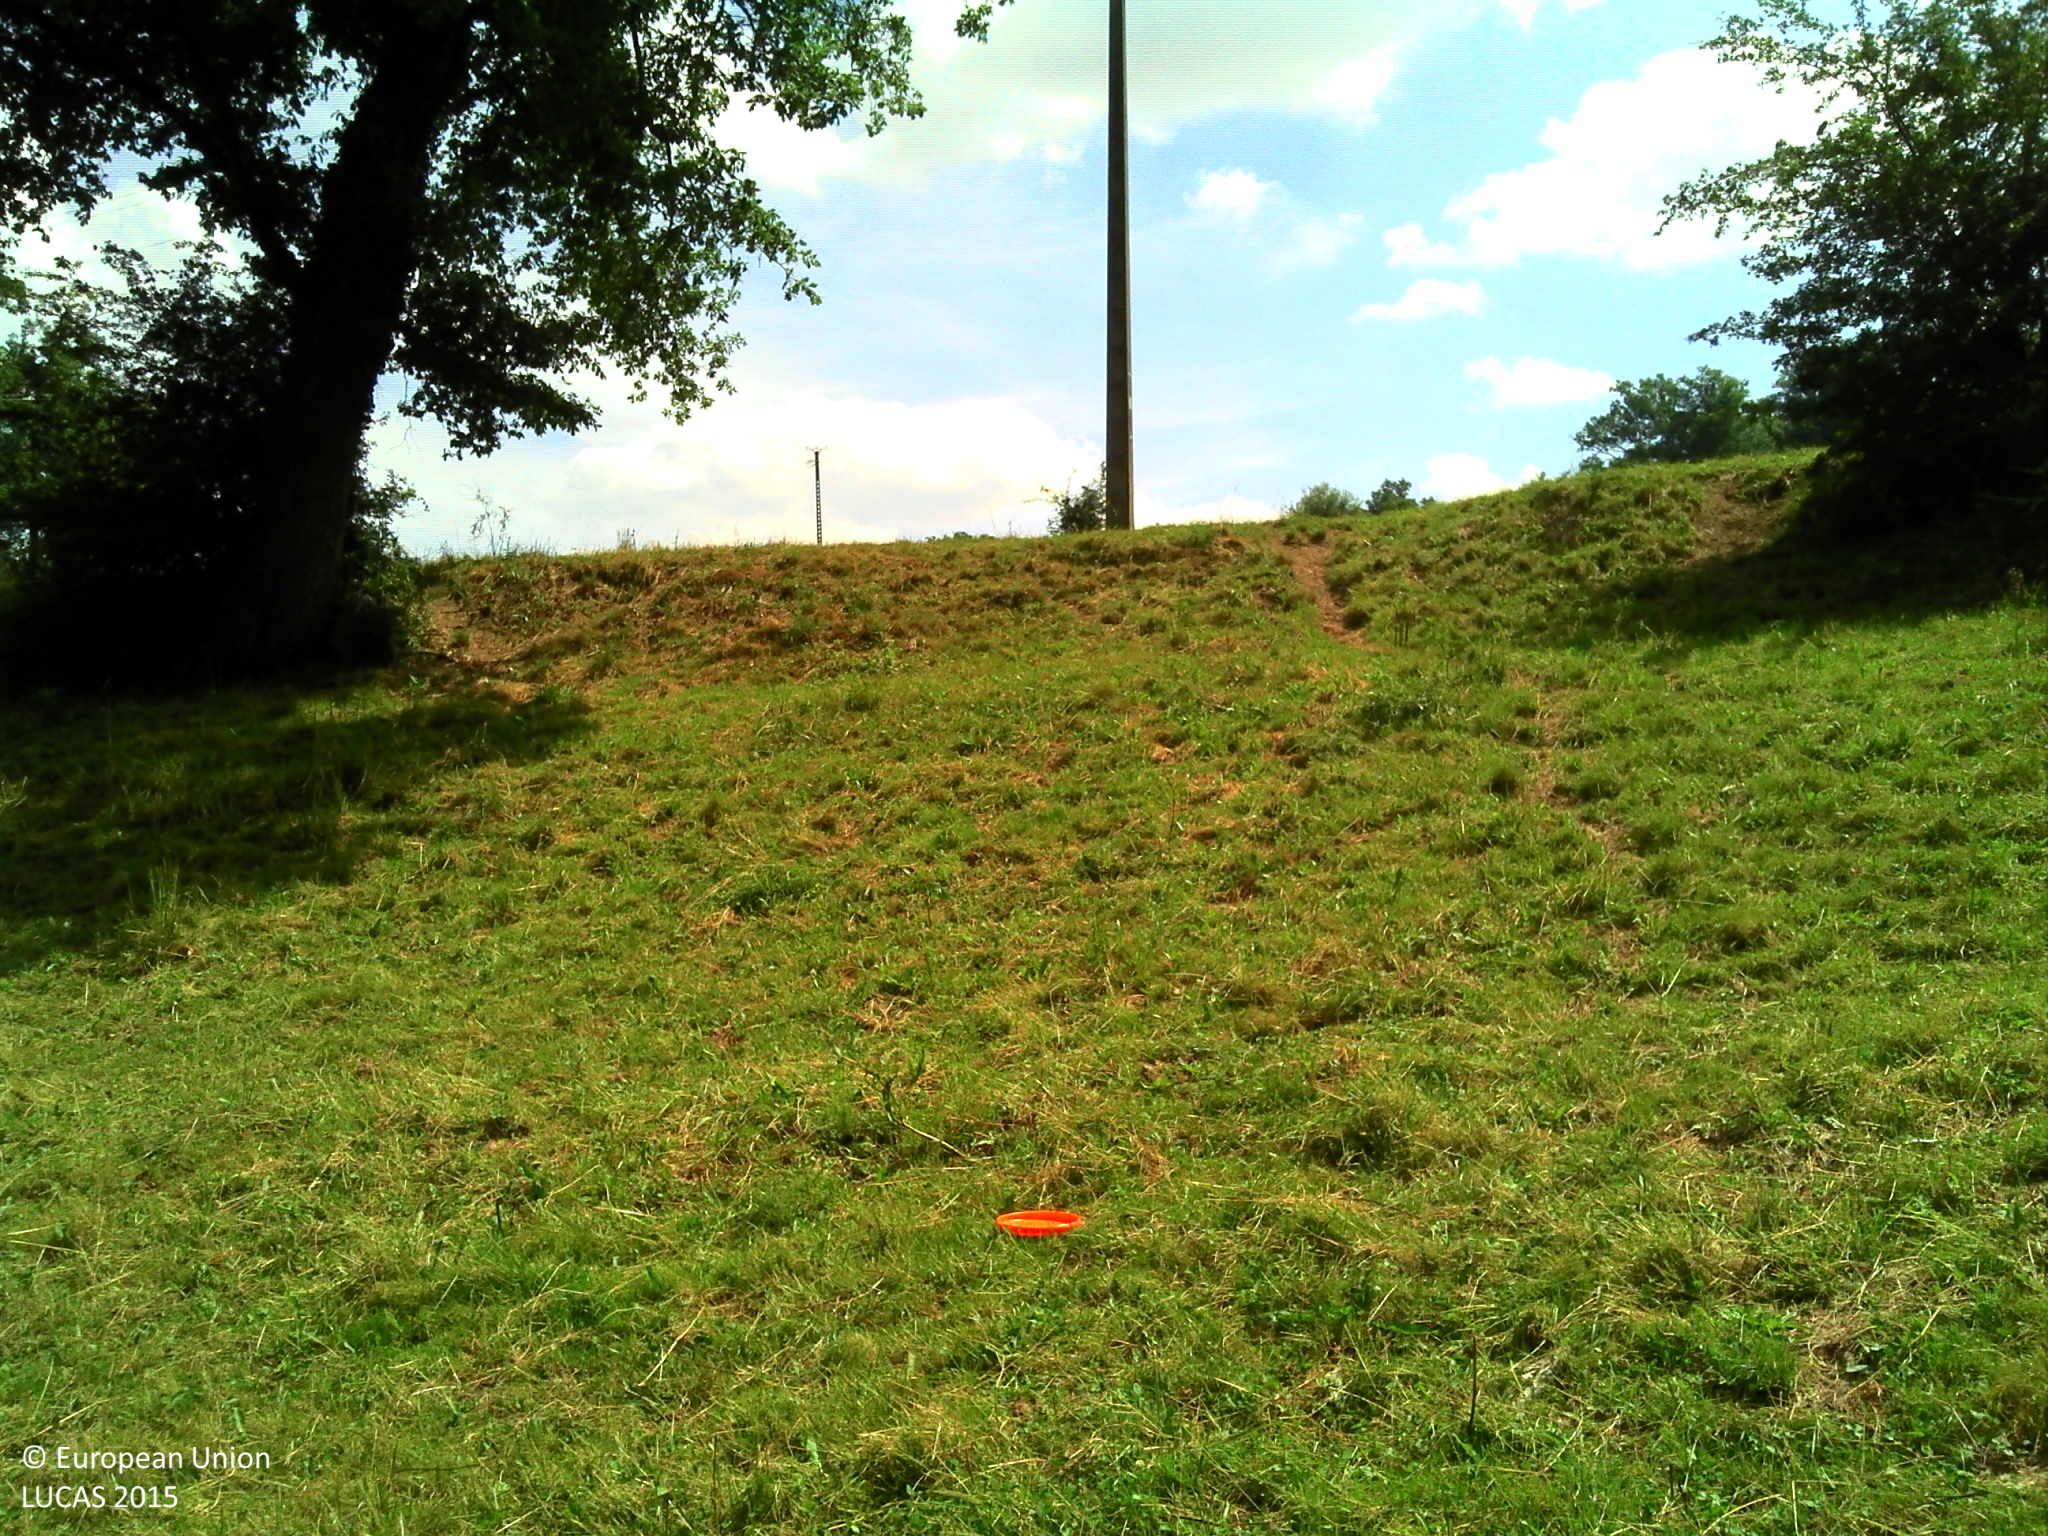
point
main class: Grassland
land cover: Grassland without tree/shrub cover
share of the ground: > 75 %
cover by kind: herbaceous plants 100 %
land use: Agriculture (excluding fallow land and kitchen gardens)
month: June
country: FR
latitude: 44.2445
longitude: 2.0502
